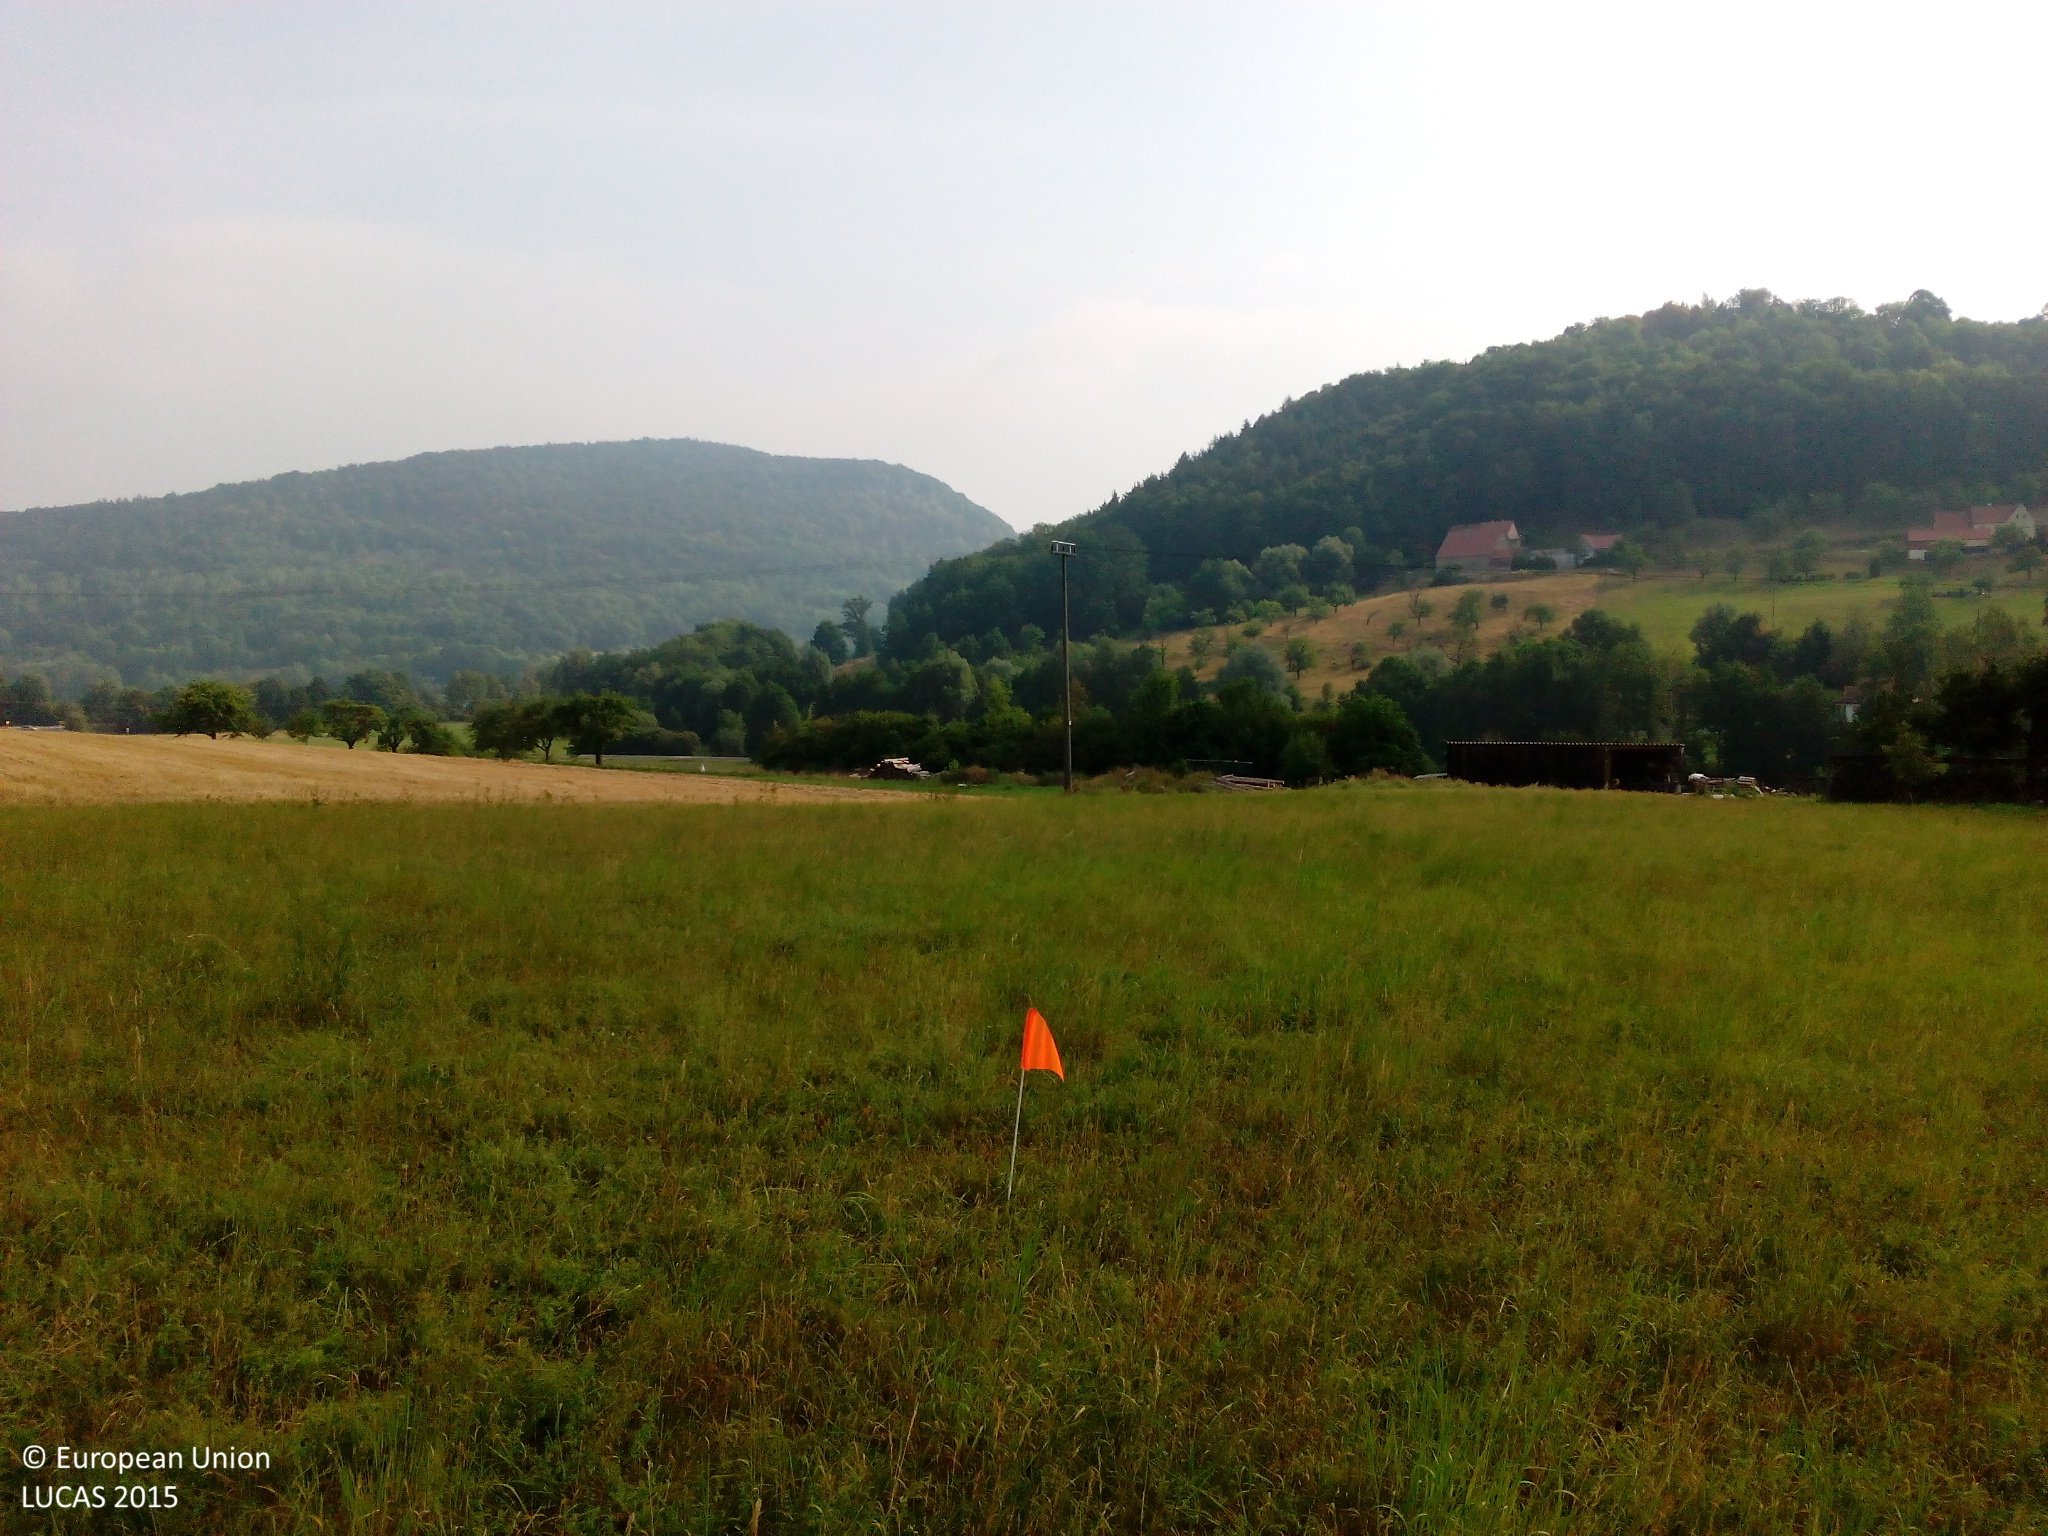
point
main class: Grassland
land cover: Grassland without tree/shrub cover
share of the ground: > 75 %
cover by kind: herbaceous plants 95 %
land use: Agriculture (excluding fallow land and kitchen gardens)
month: August
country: DE
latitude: 49.4732
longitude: 11.4762
